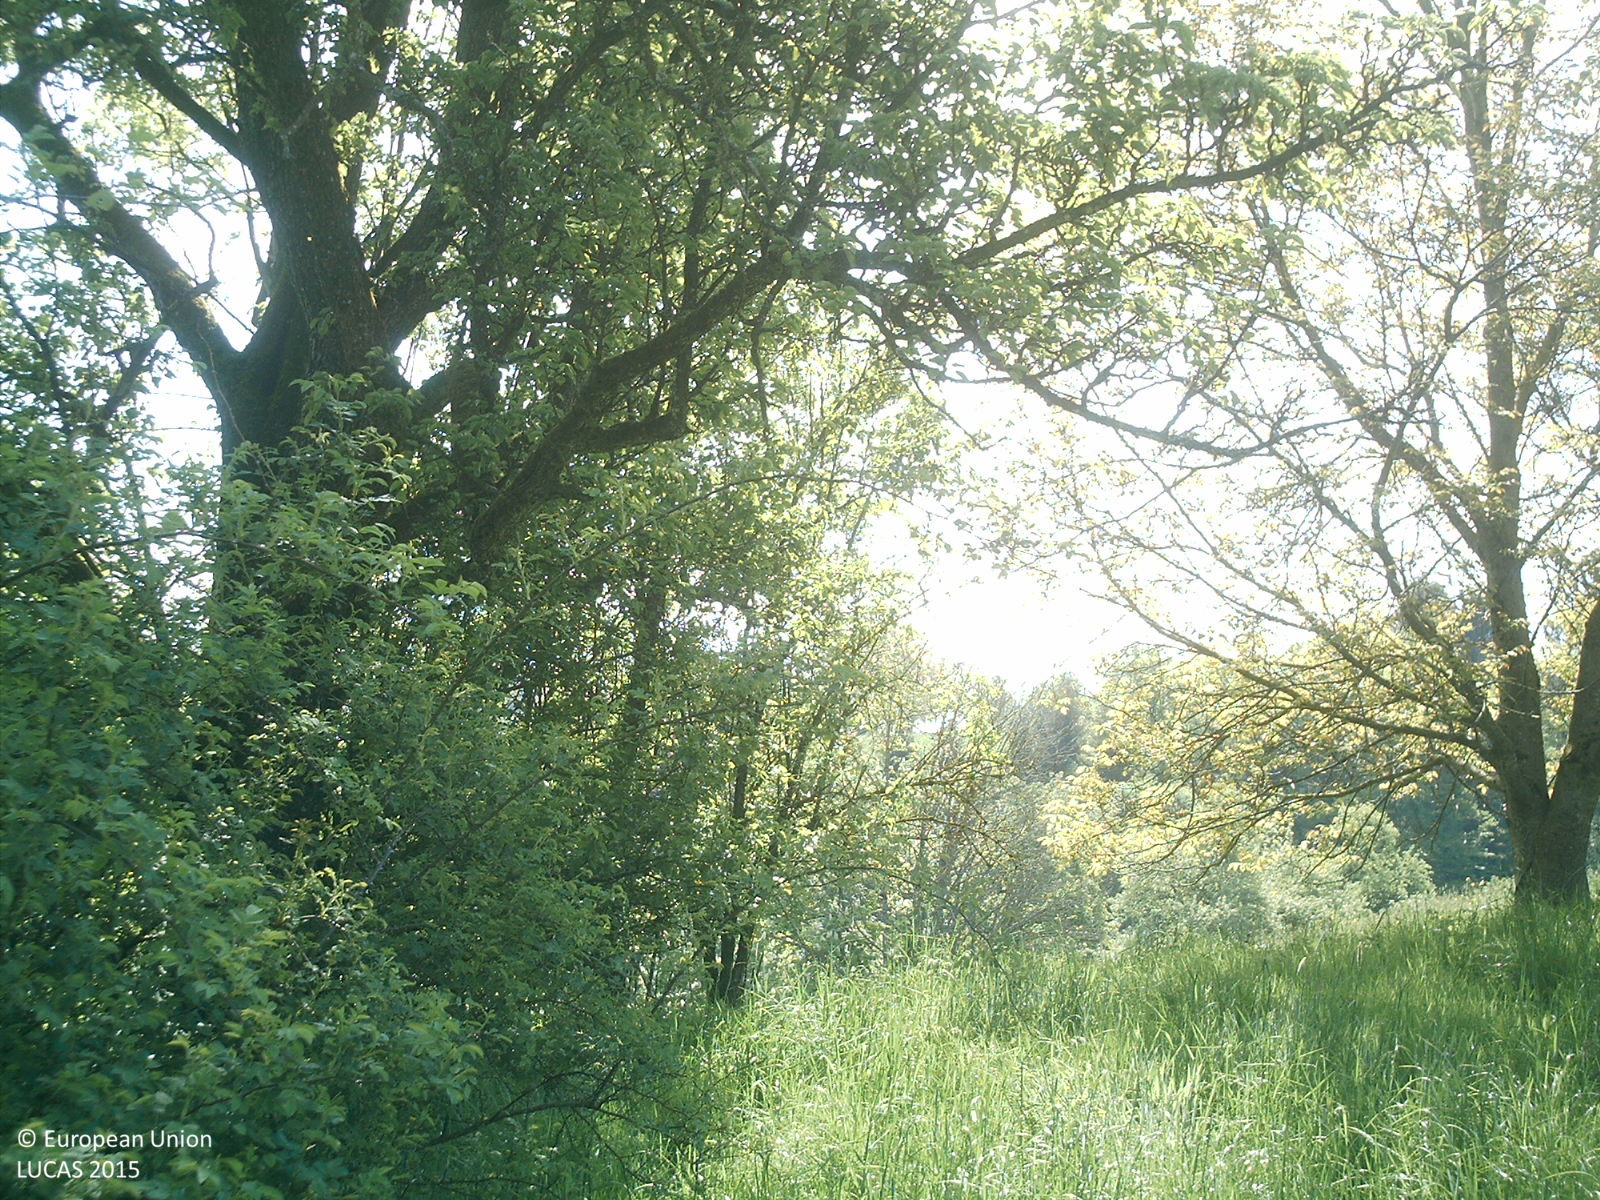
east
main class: Woodland
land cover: Broadleaved woodland
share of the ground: 50 - 75 %
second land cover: Grassland without tree/shrub cover
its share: > 75 %
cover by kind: broadleaved forest trees 50 %, shrubs 50 %
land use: Residential
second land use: Agriculture (excluding fallow land and kitchen gardens)
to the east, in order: Broadleaved woodland; Grassland without tree/shrub cover; Grass margins; Artificial constructions in urban areas; Grassland without tree/shrub cover; Paved roads, cycling and walking lanes; Grassland without tree/shrub cover; Tracks; Grassland without tree/shrub cover; Spruce dominated mixed woodland; Rivers and streams; Broadleaved woodland; Fences; Tracks; Spruce dominated mixed woodland; Grassland without tree/shrub cover; Tracks; Fences; Lines of trees; Grassland without tree/shrub cover
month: May
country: AT
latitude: 47.9138
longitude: 14.0804
